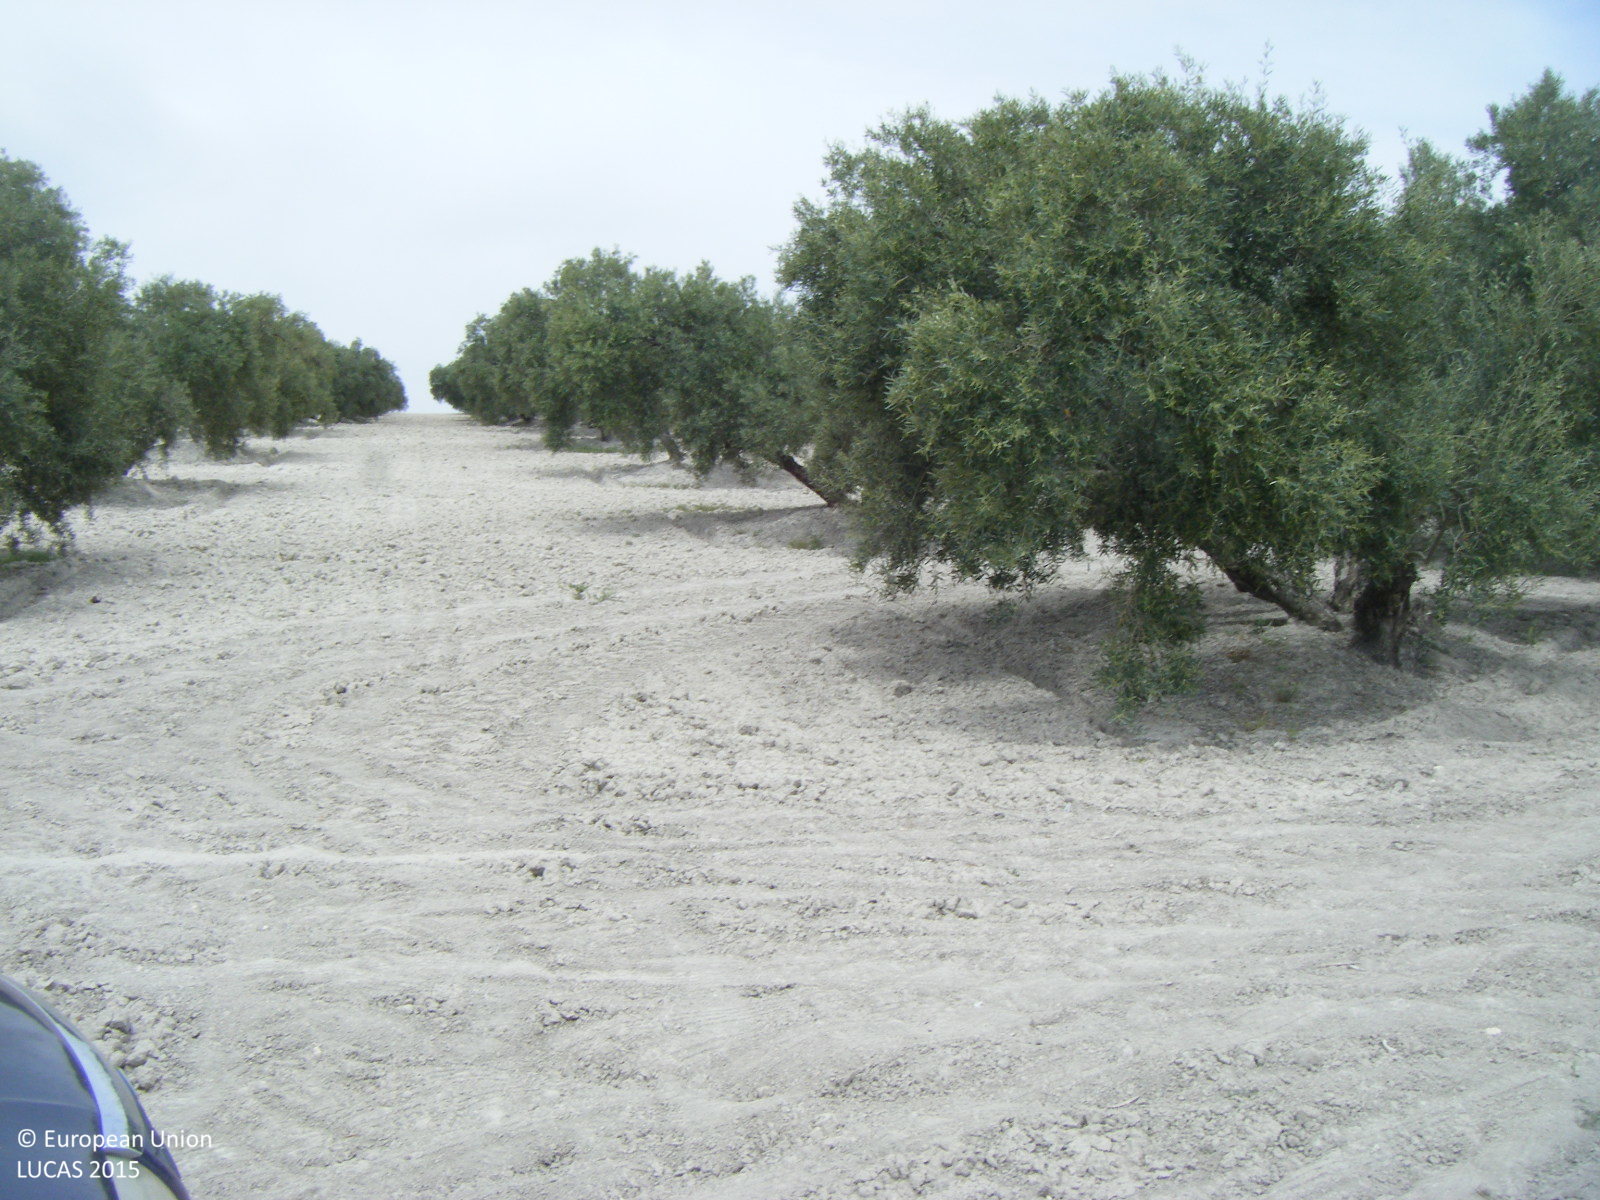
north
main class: Shrubland
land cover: Shrubland without tree cover
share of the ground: > 75 %
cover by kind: shrubs 80 %, herbaceous plants 20 %
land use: Semi-natural and natural areas not in use
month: April
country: ES
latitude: 37.1195
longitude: -4.7785
